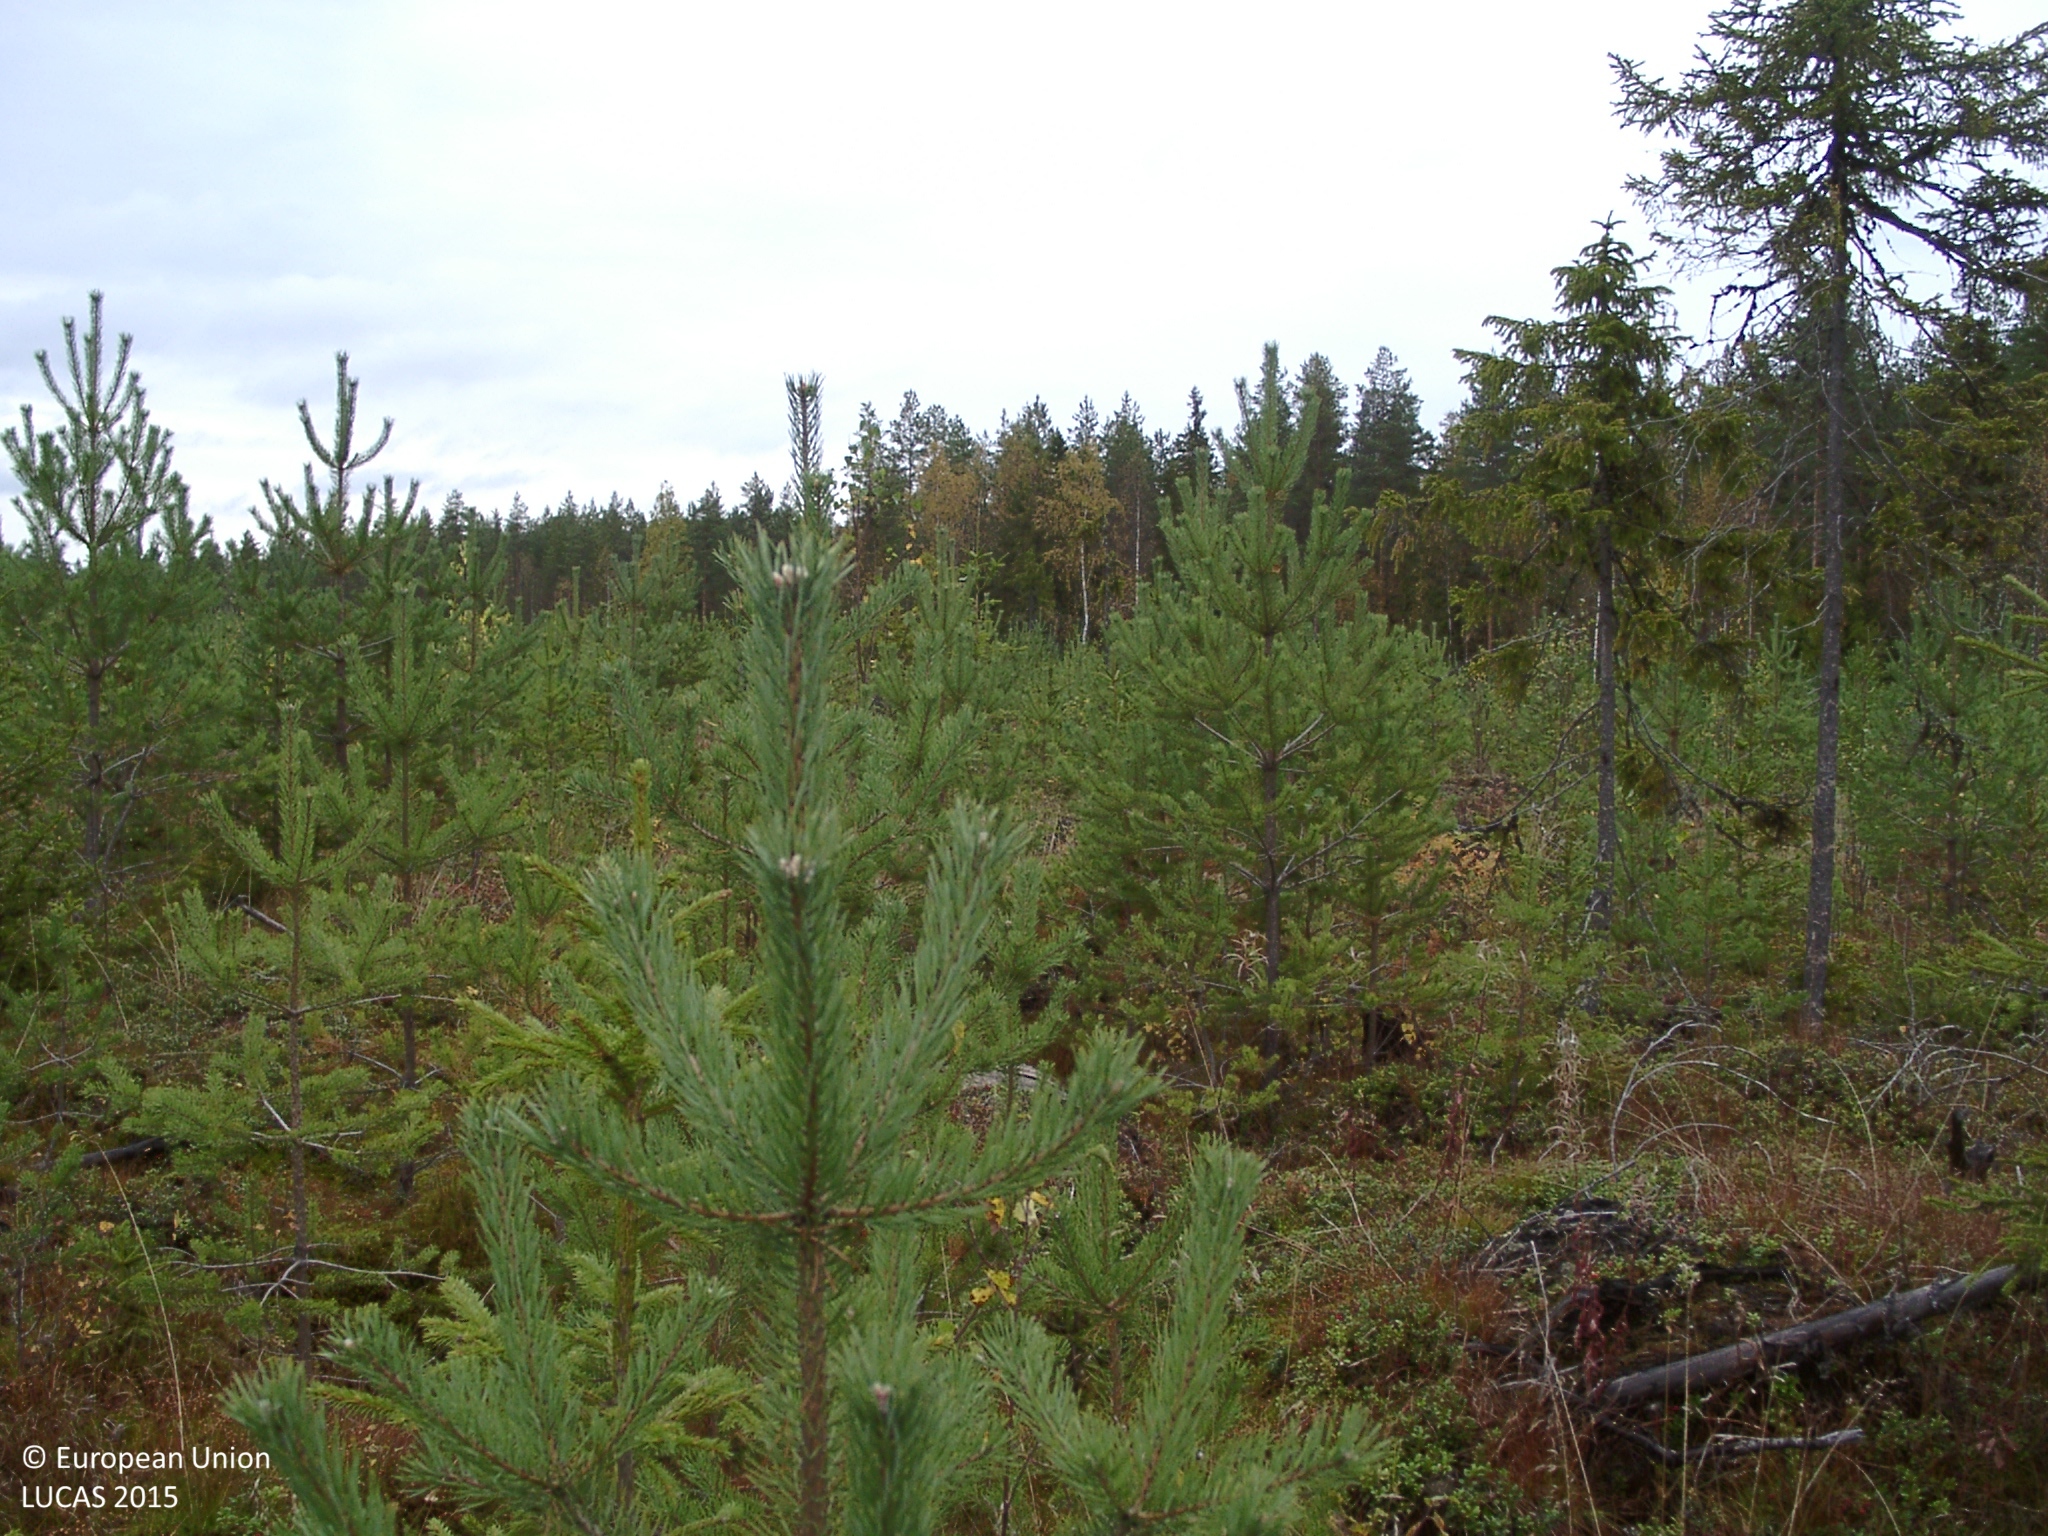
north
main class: Woodland
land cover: Pine dominated coniferous woodland
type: boreal forest
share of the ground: 10 - 25 %
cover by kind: lichens and mosses 30 %, shrubs 25 %, herbaceous plants 25 %, coniferous forest trees 20 %
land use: Forestry
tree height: < 5 m
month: September
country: FI
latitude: 62.8199
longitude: 25.4727
